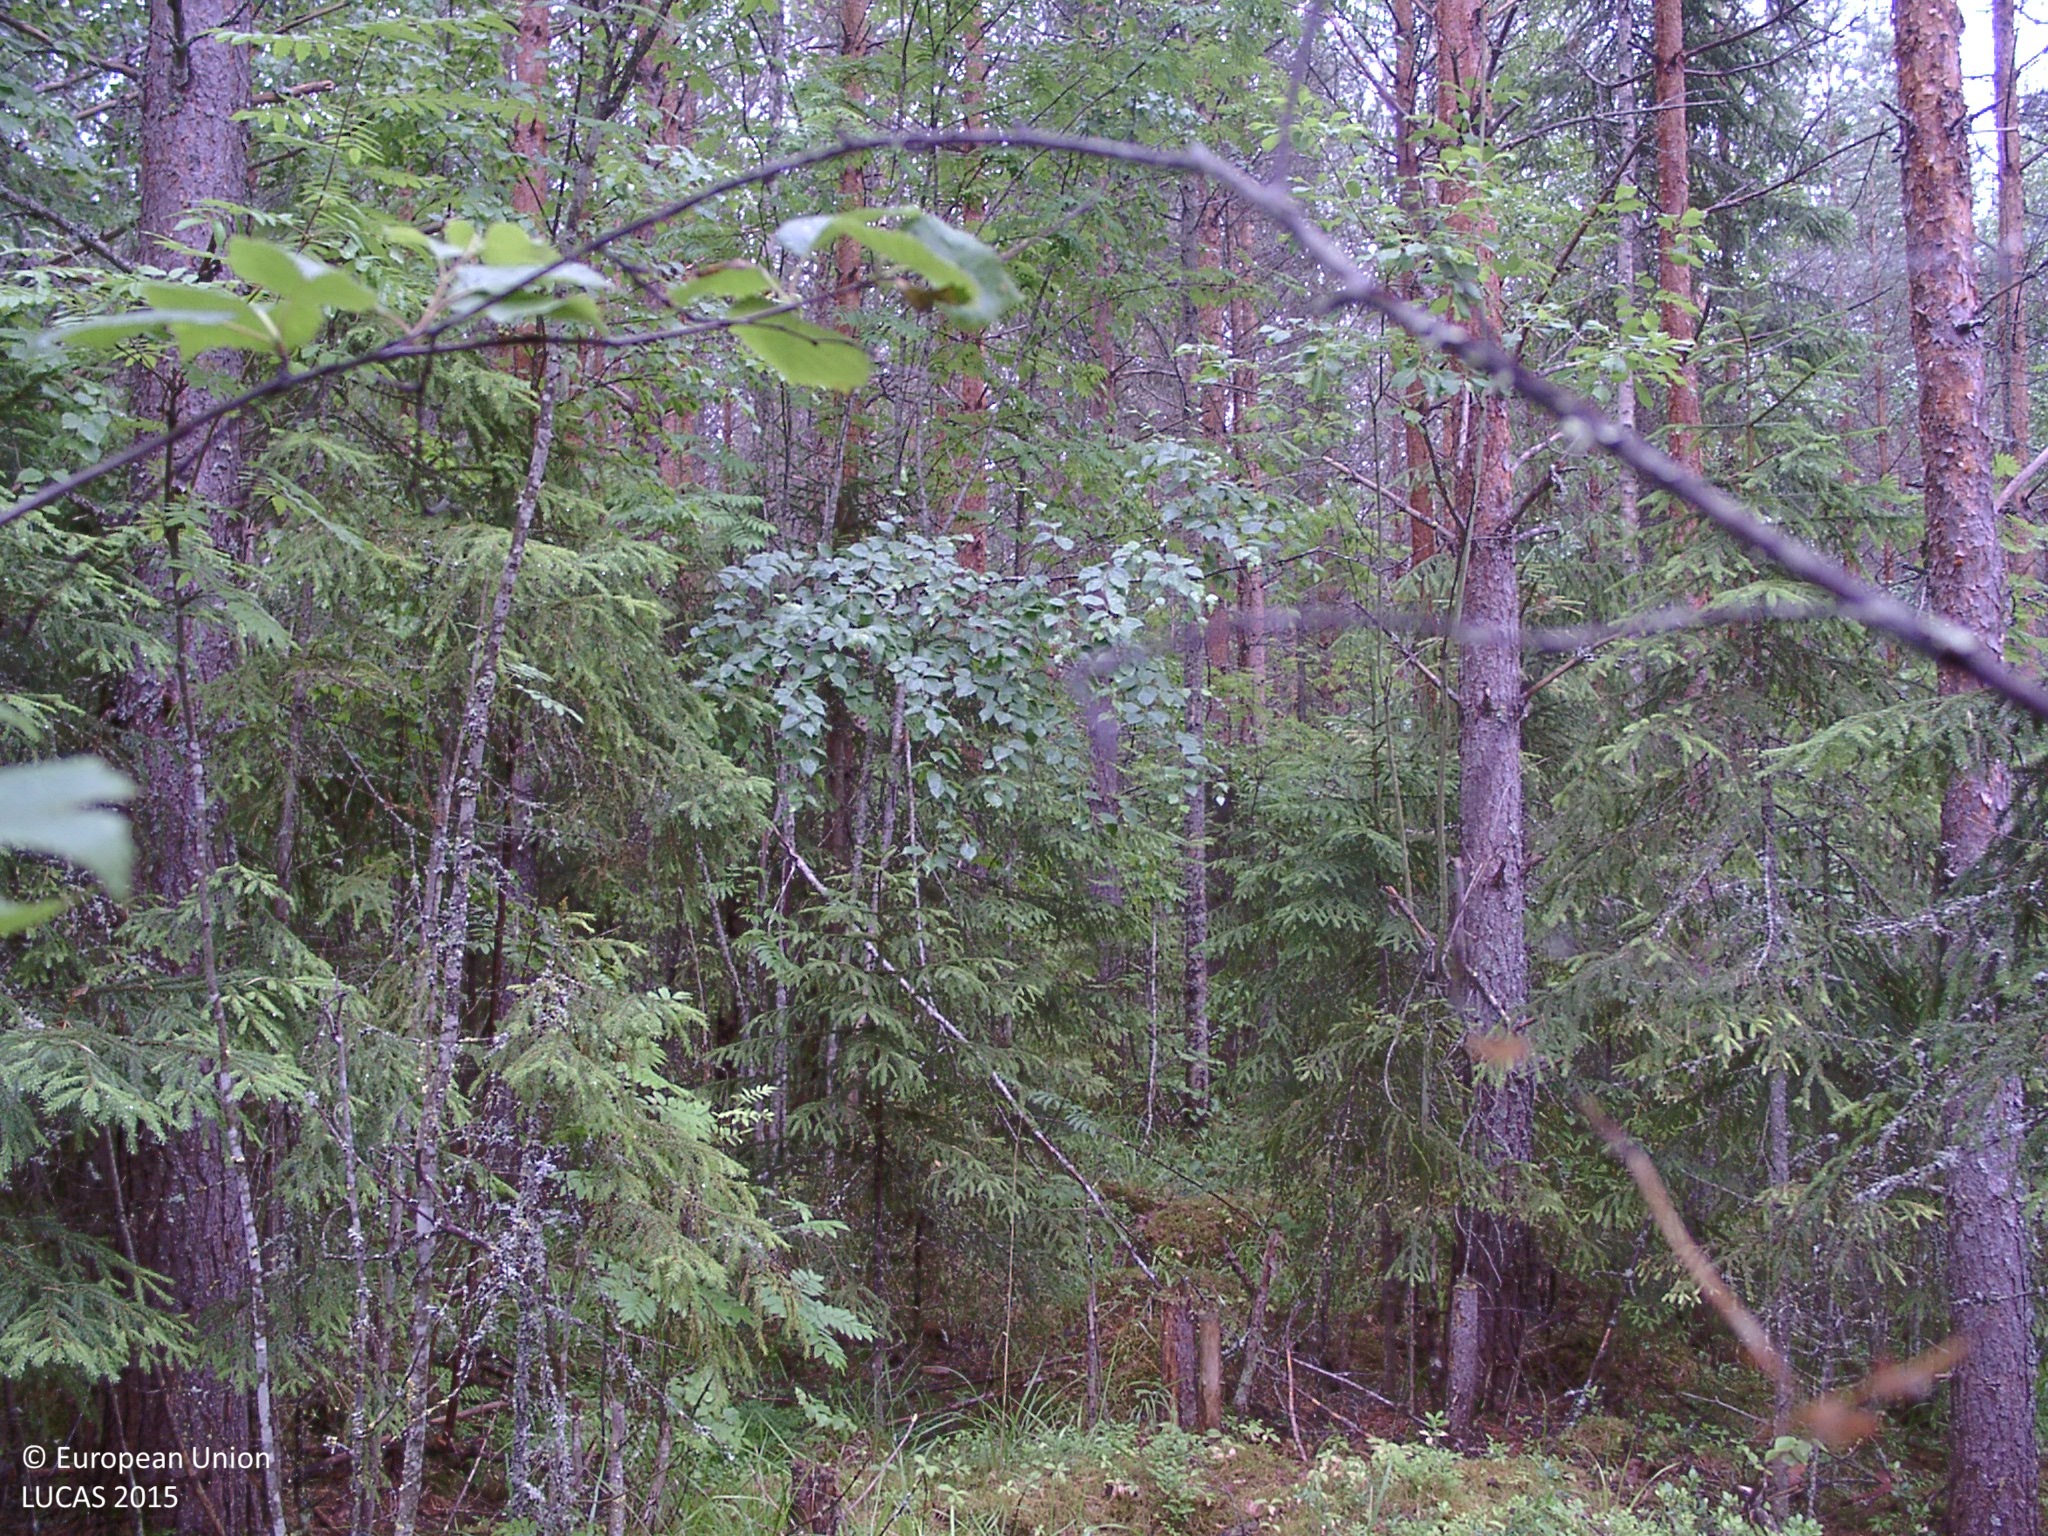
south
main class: Woodland
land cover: Other mixed woodland
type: boreal forest
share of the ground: 50 - 75 %
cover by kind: coniferous forest trees 50 %, broadleaved forest trees 35 %, shrubs 5 %, herbaceous plants 5 %, lichens and mosses 5 %
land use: Semi-natural and natural areas not in use
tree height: > 5 m
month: July
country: FI
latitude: 62.1075
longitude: 25.2274
